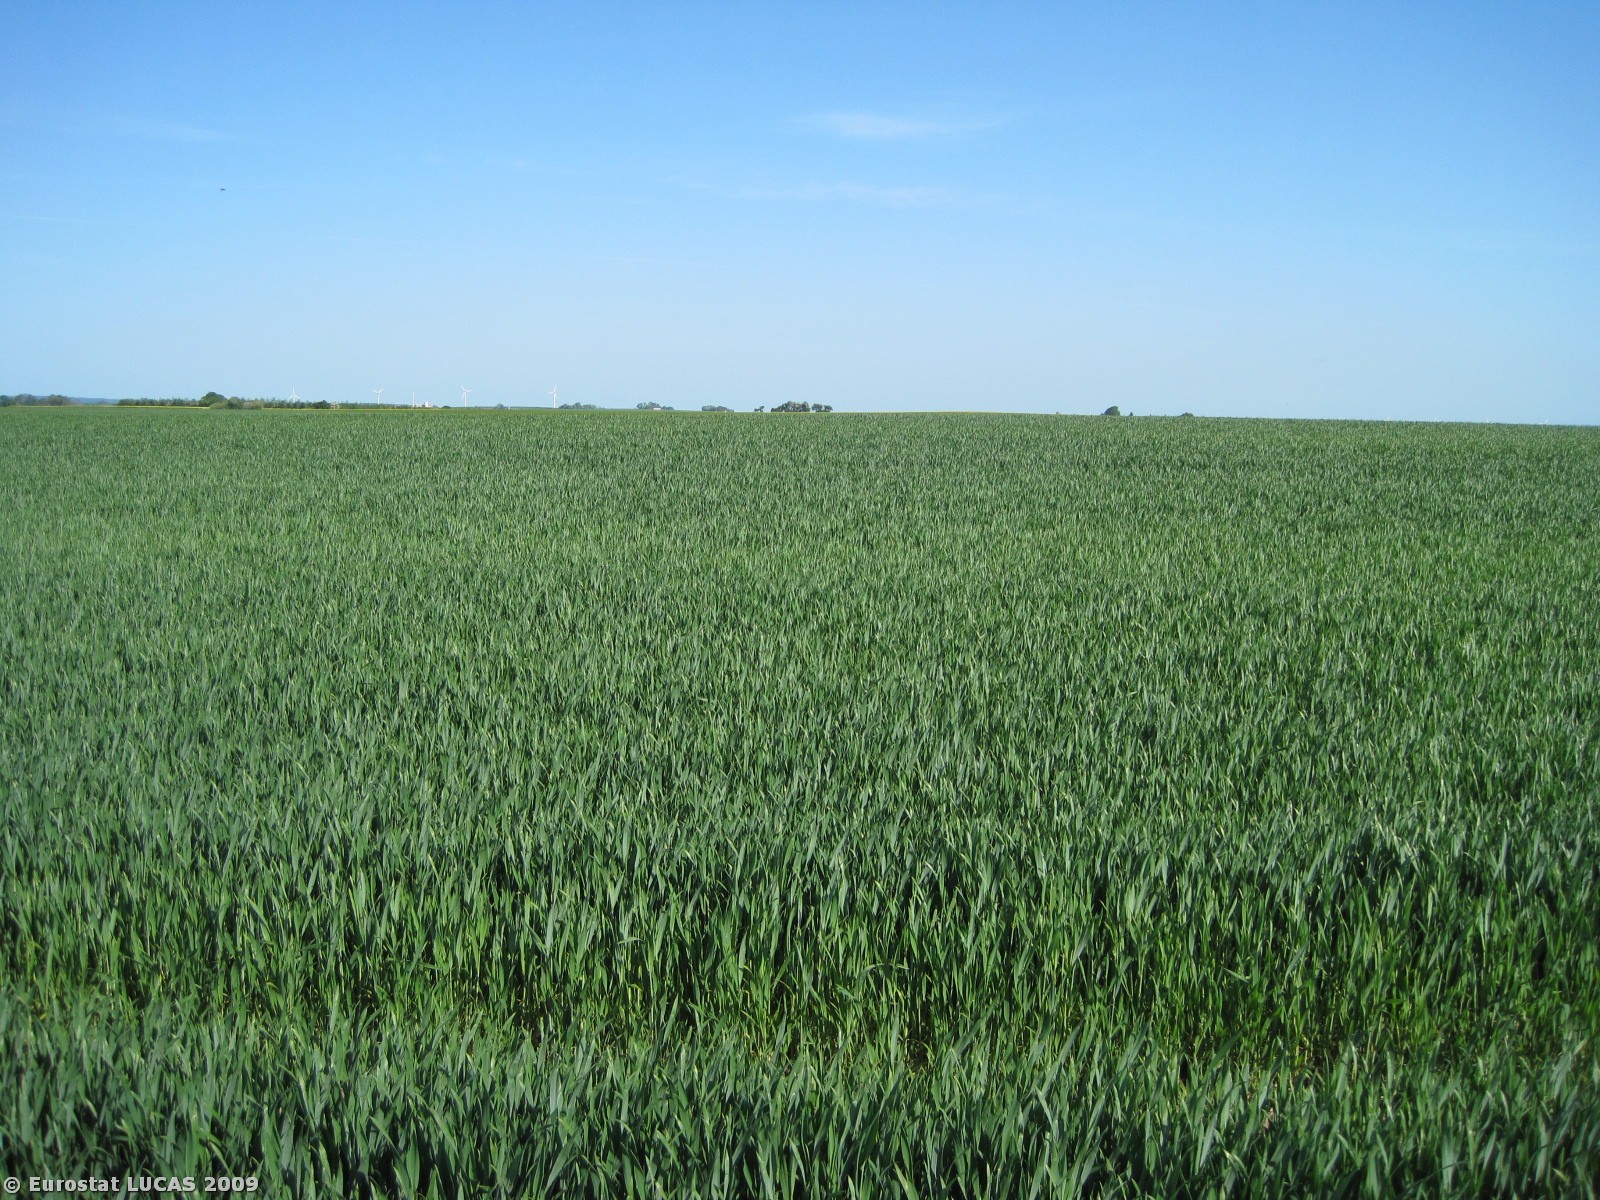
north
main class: Cropland
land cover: Common wheat
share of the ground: > 75 %
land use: Agriculture (excluding fallow land and kitchen gardens)
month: May
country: DK
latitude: 56.5651
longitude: 10.1788
